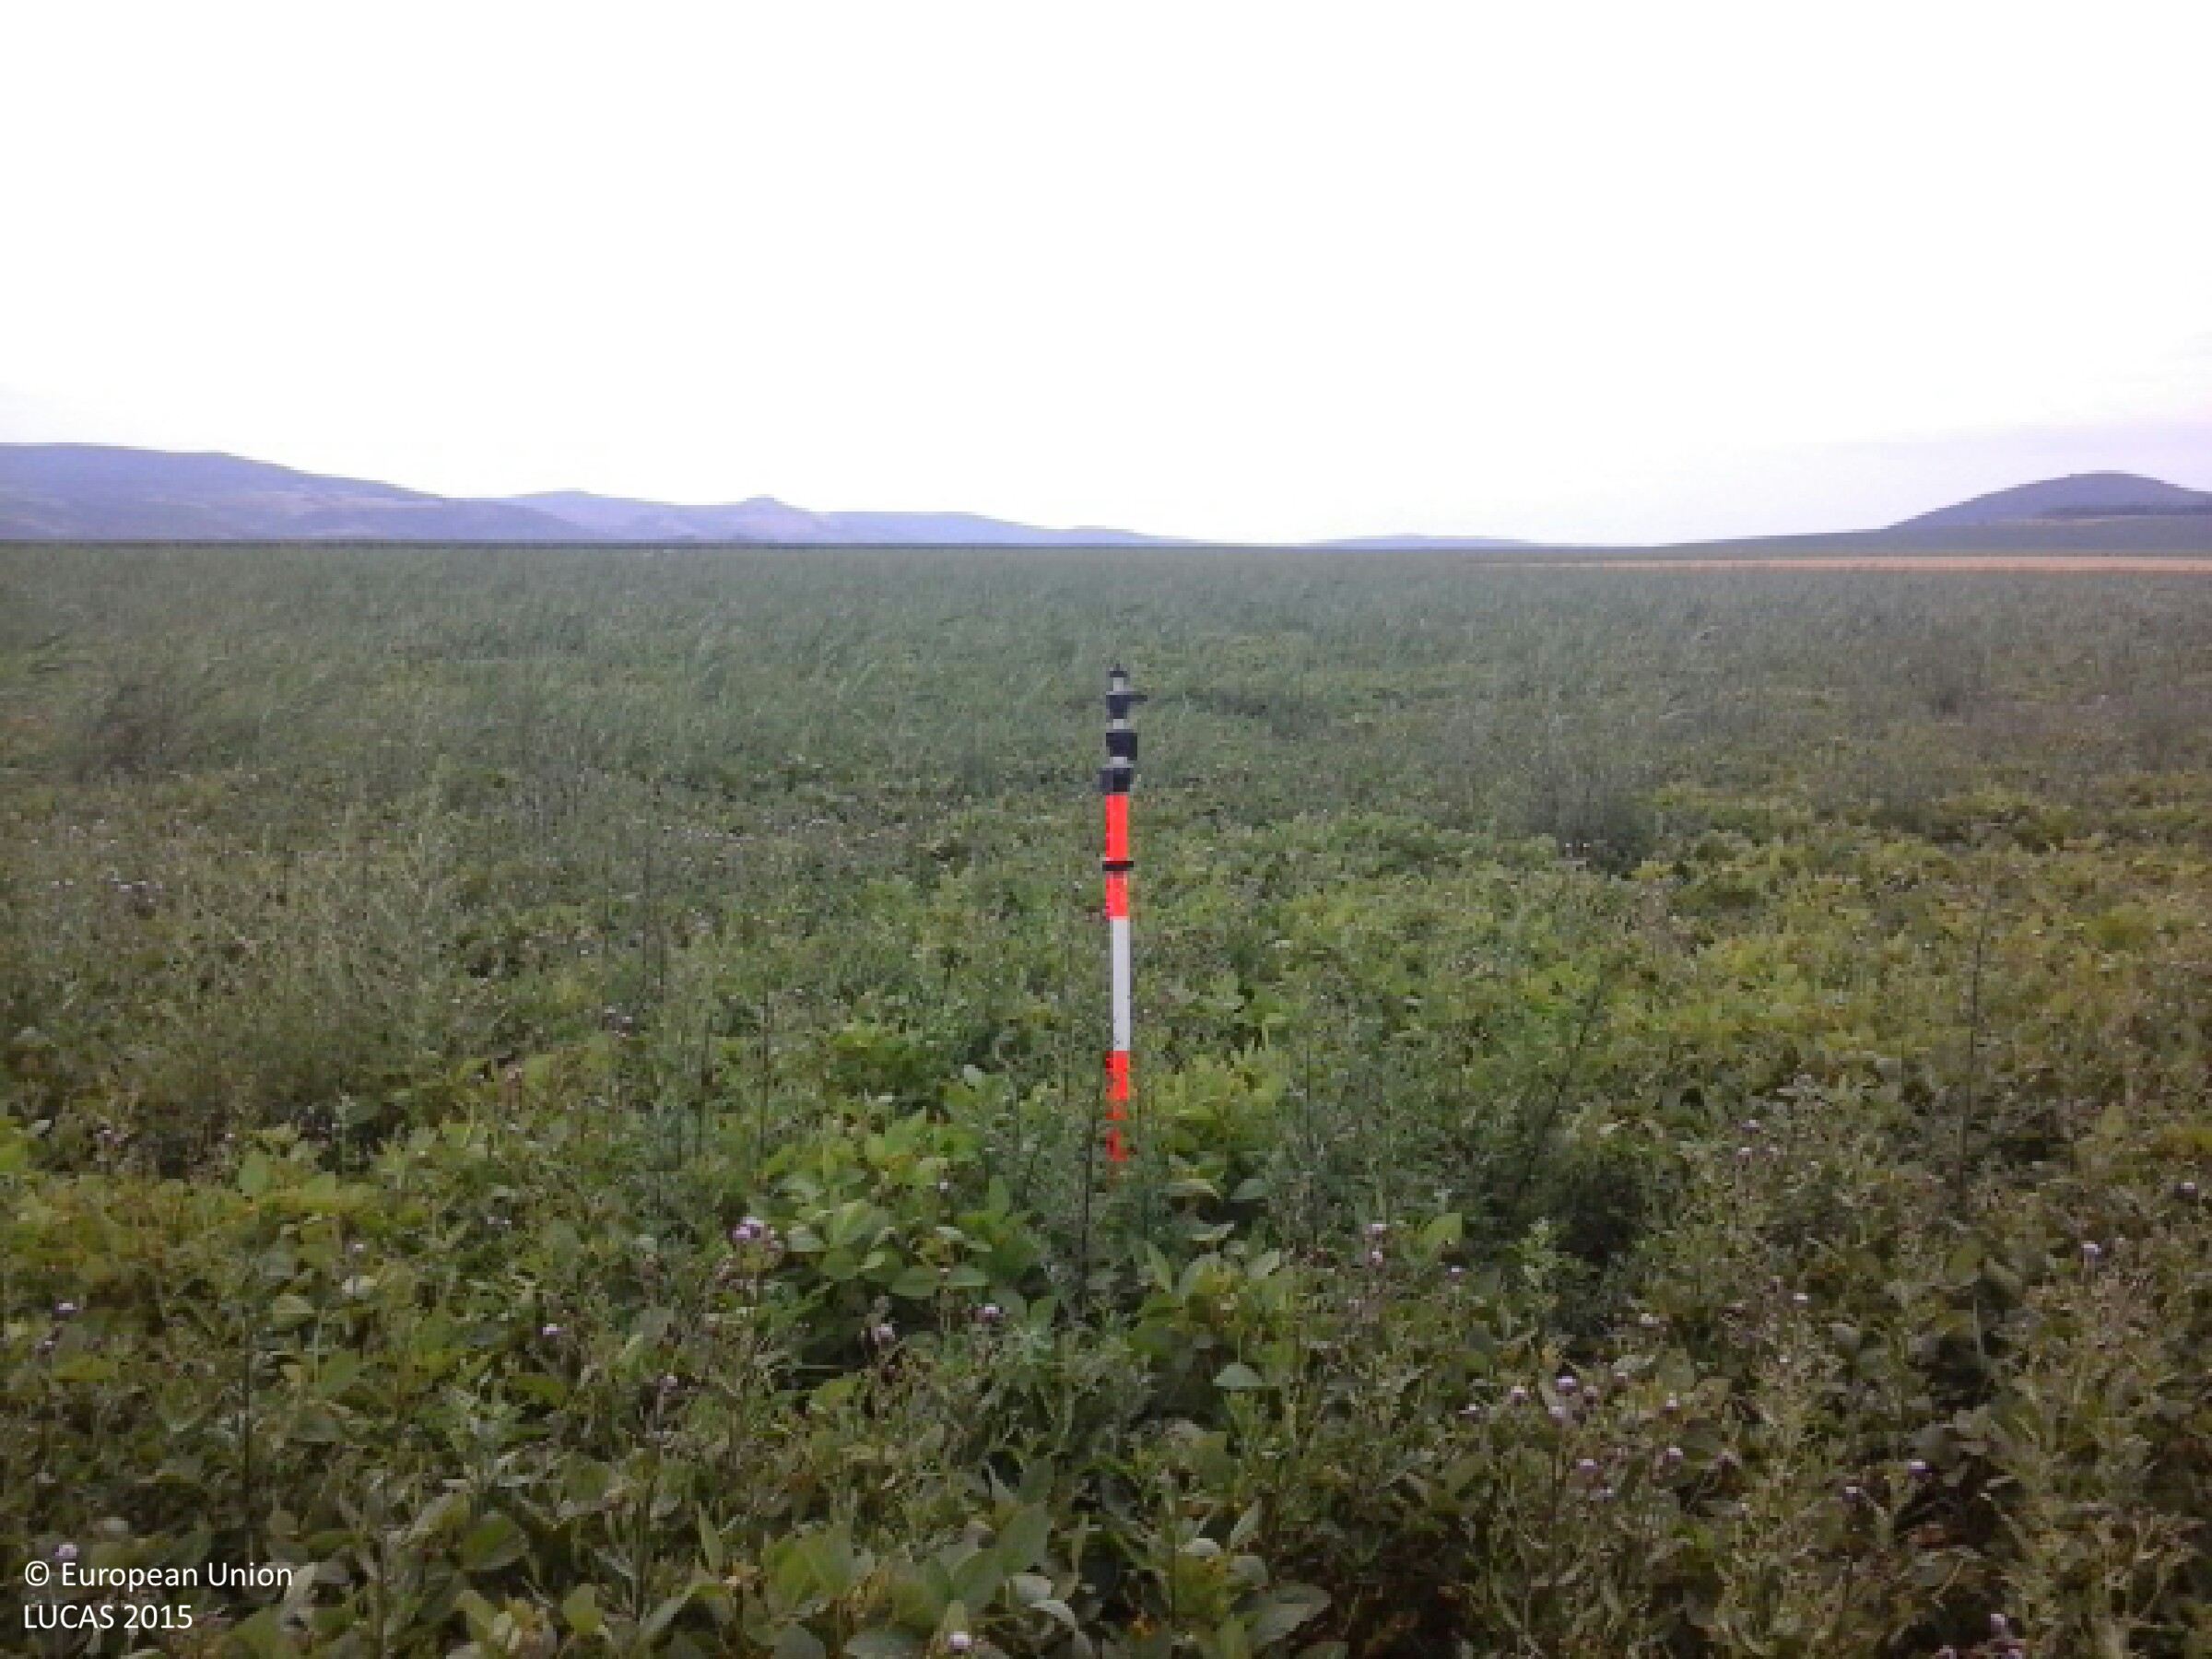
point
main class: Grassland
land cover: Spontaneously vegetated surfaces
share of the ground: > 75 %
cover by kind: herbaceous plants 100 %
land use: Abandoned areas
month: July
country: HU
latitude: 48.2550
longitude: 21.1536
